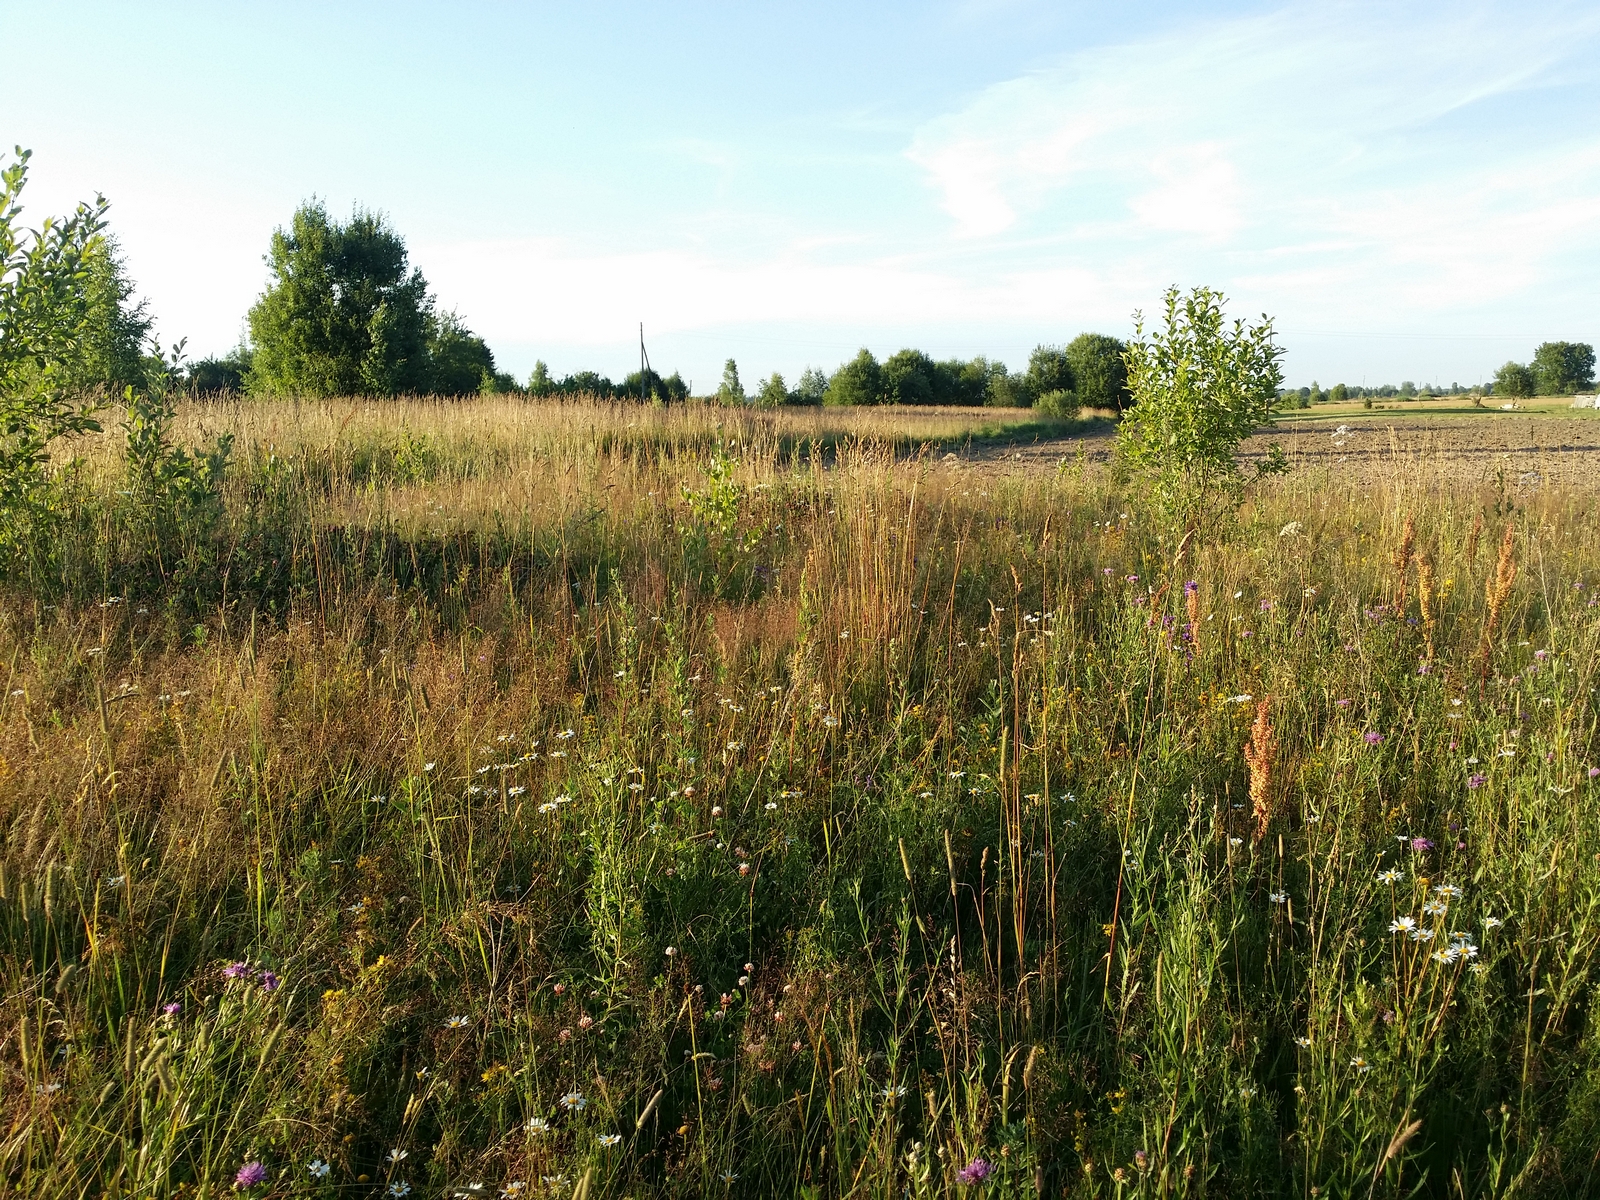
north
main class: Grassland
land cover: Spontaneously vegetated surfaces
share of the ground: > 75 %
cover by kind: herbaceous plants 100 %
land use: Semi-natural and natural areas not in use
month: July
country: LV
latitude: 57.1124
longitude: 27.2245
